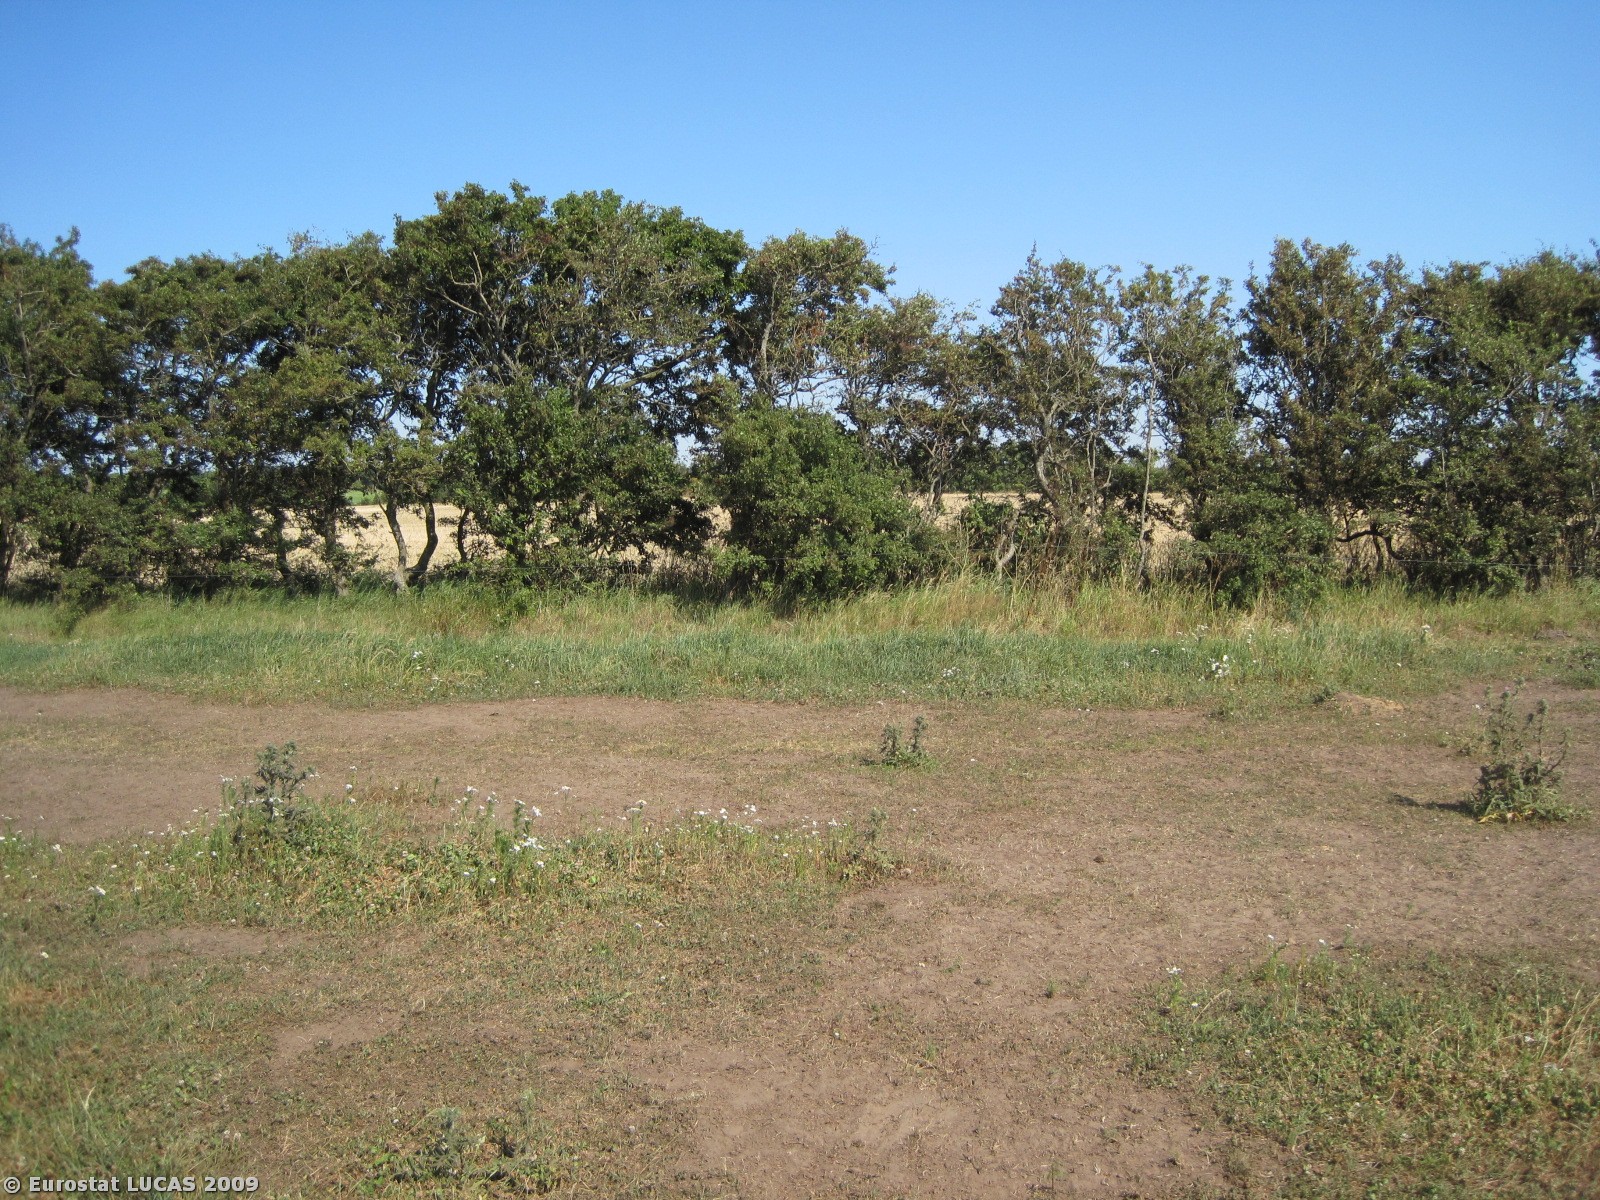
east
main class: Grassland
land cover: Grassland without tree/shrub cover
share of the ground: > 75 %
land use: Agriculture (excluding fallow land and kitchen gardens)
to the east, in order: Grassland without tree/shrub cover; Fences; Grass margins; Broadleaved woodland; Grass margins; Barley; Grass margins; Broadleaved woodland; Grass margins; Tracks; Grass margins; Barley
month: July
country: DK
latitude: 56.4127
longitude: 8.4945
